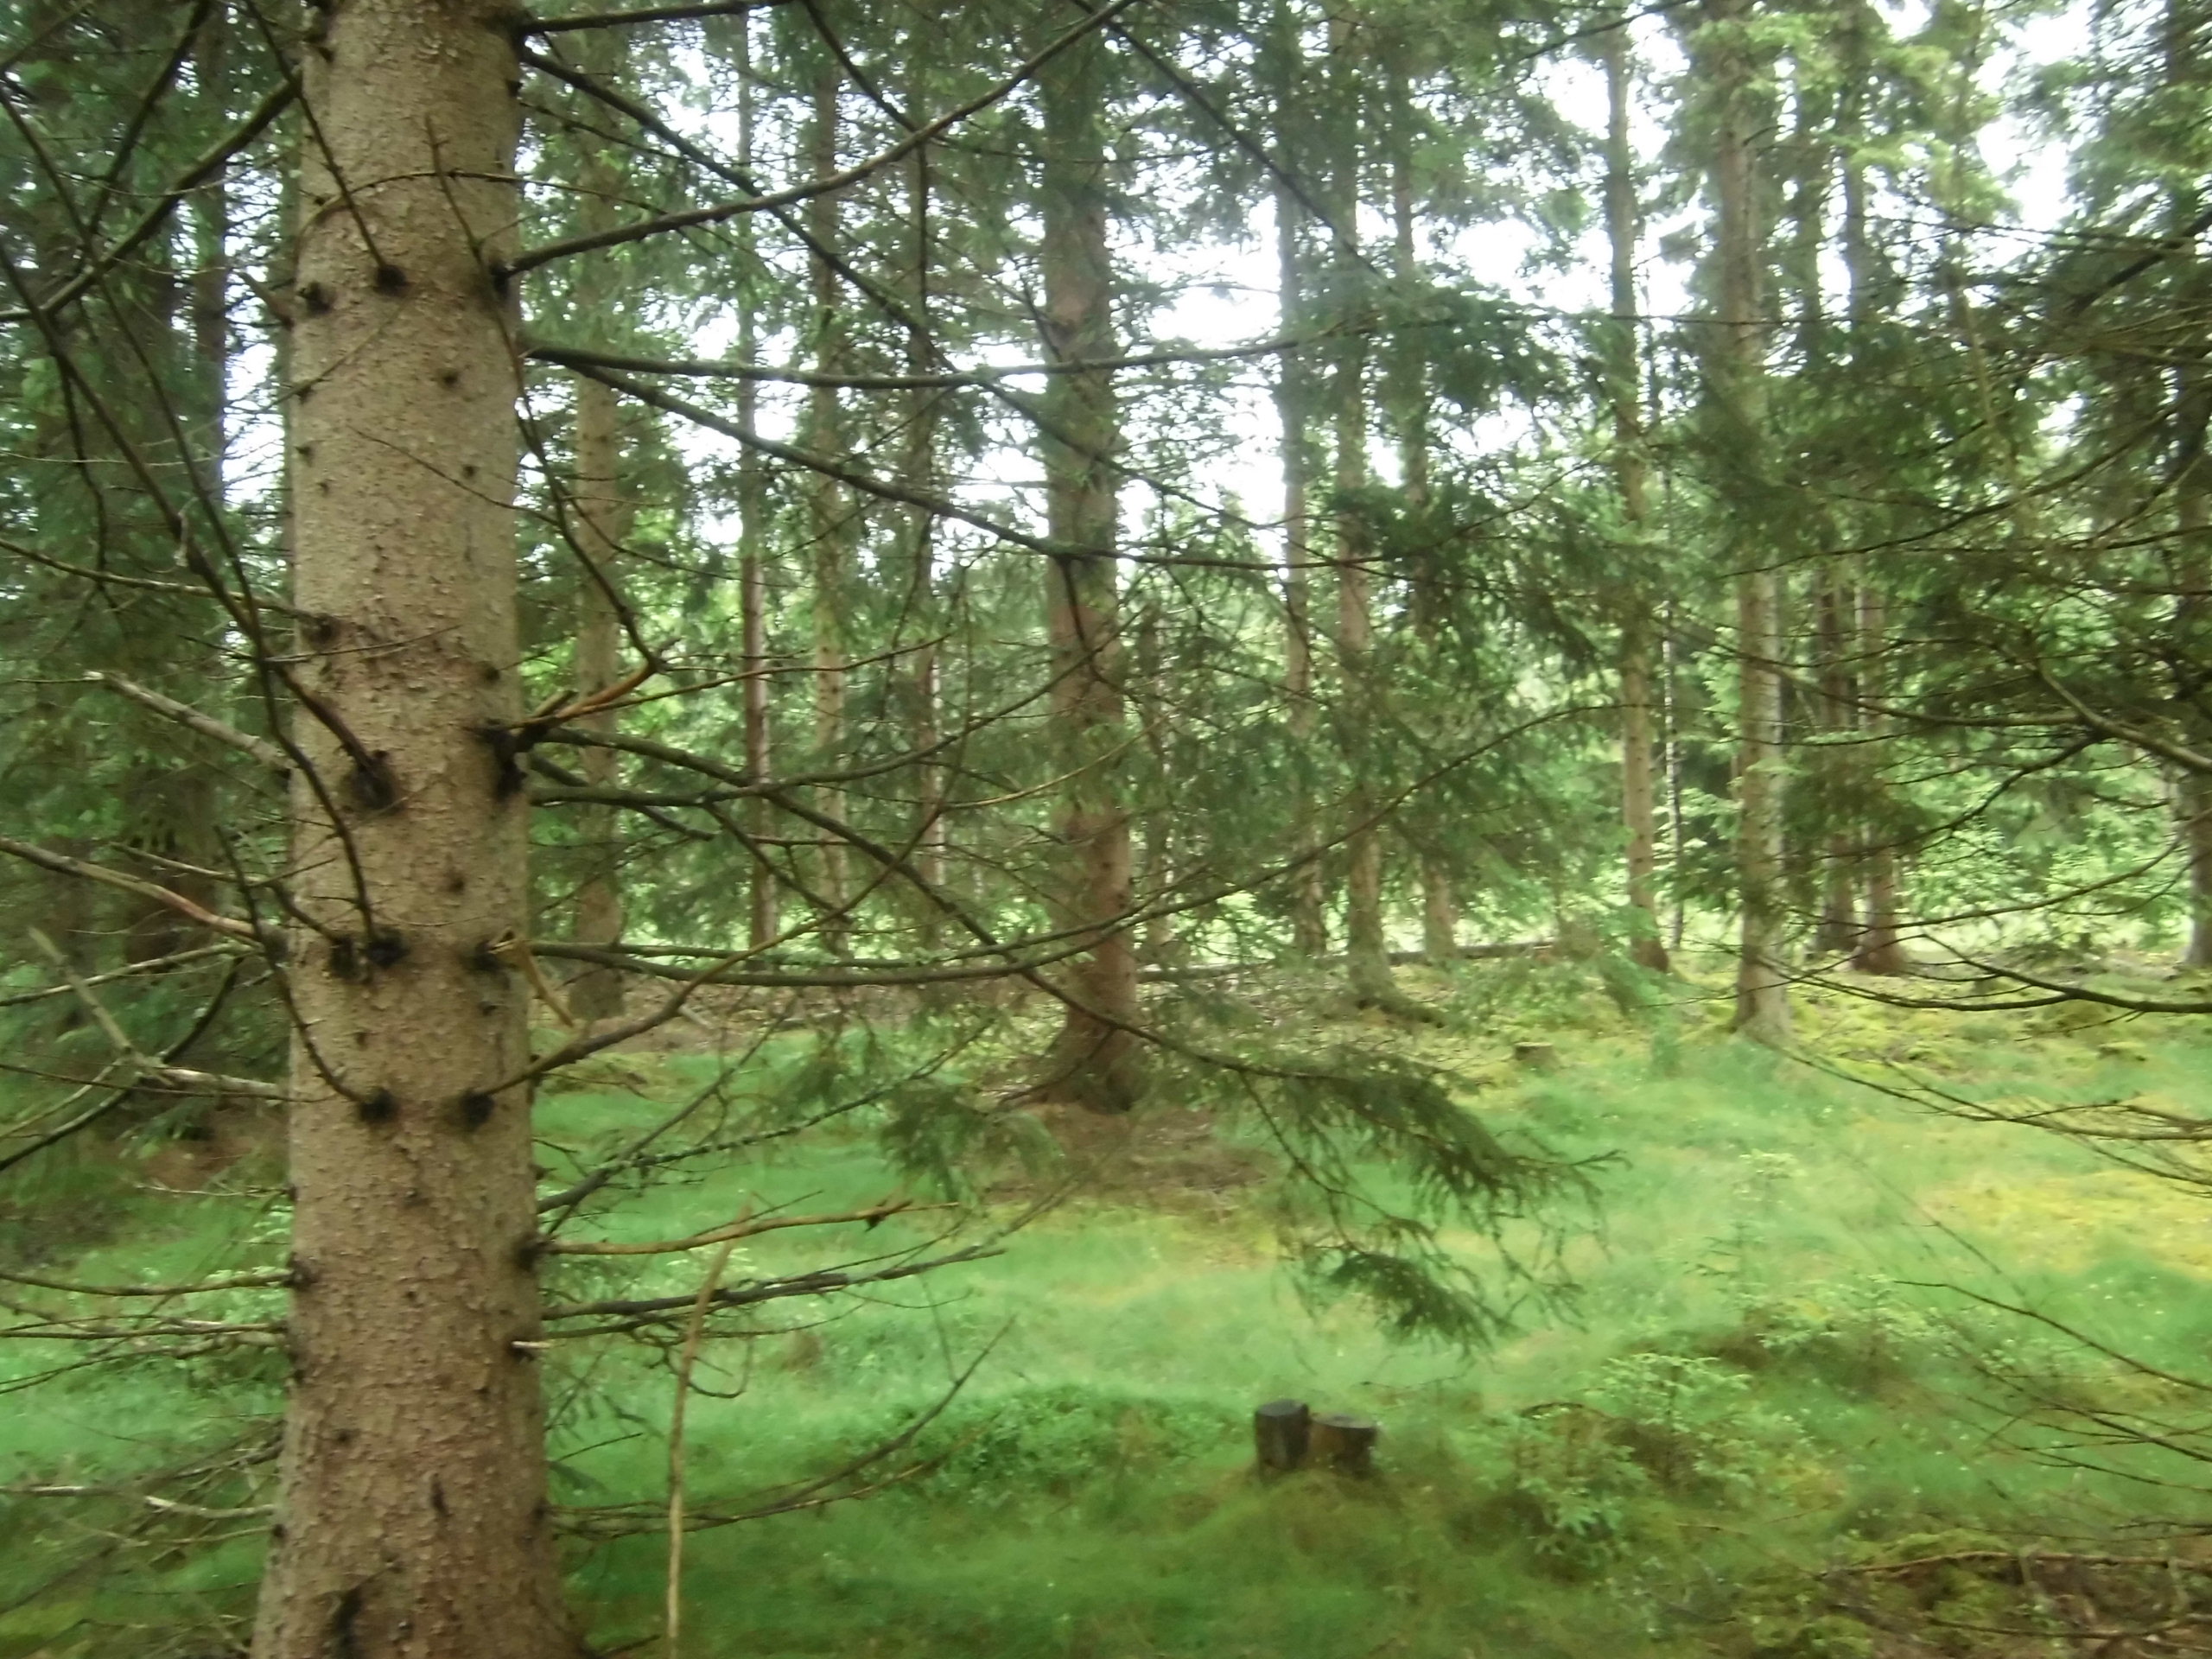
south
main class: Woodland
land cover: Spruce dominated coniferous woodland
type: boreal forest
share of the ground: 50 - 75 %
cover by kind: coniferous forest trees 60 %, lichens and mosses 20 %, herbaceous plants 10 %, broadleaved forest trees 5 %, shrubs 5 %
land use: Forestry
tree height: > 5 m
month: July
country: SE
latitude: 57.1236
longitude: 15.2994
